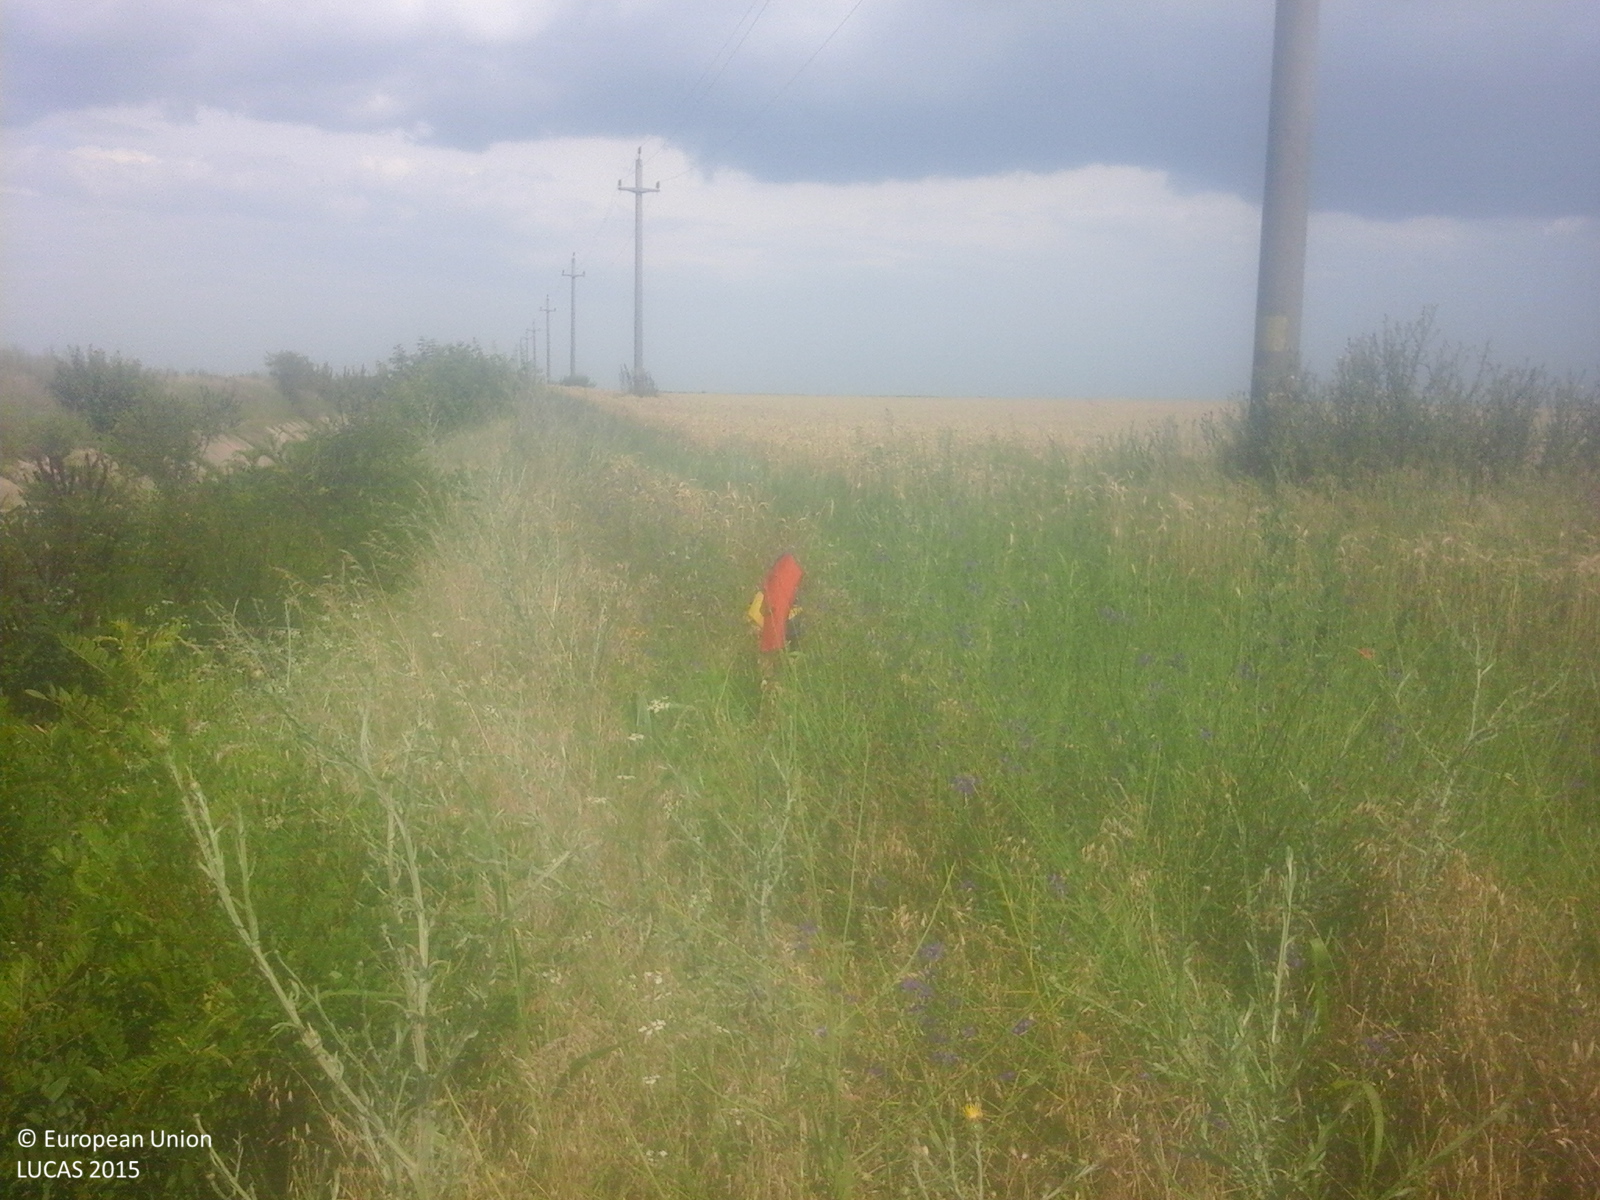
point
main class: Grassland
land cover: Spontaneously vegetated surfaces
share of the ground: > 75 %
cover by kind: herbaceous plants 100 %
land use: Fallow land
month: July
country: RO
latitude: 43.8130
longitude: 24.5488
